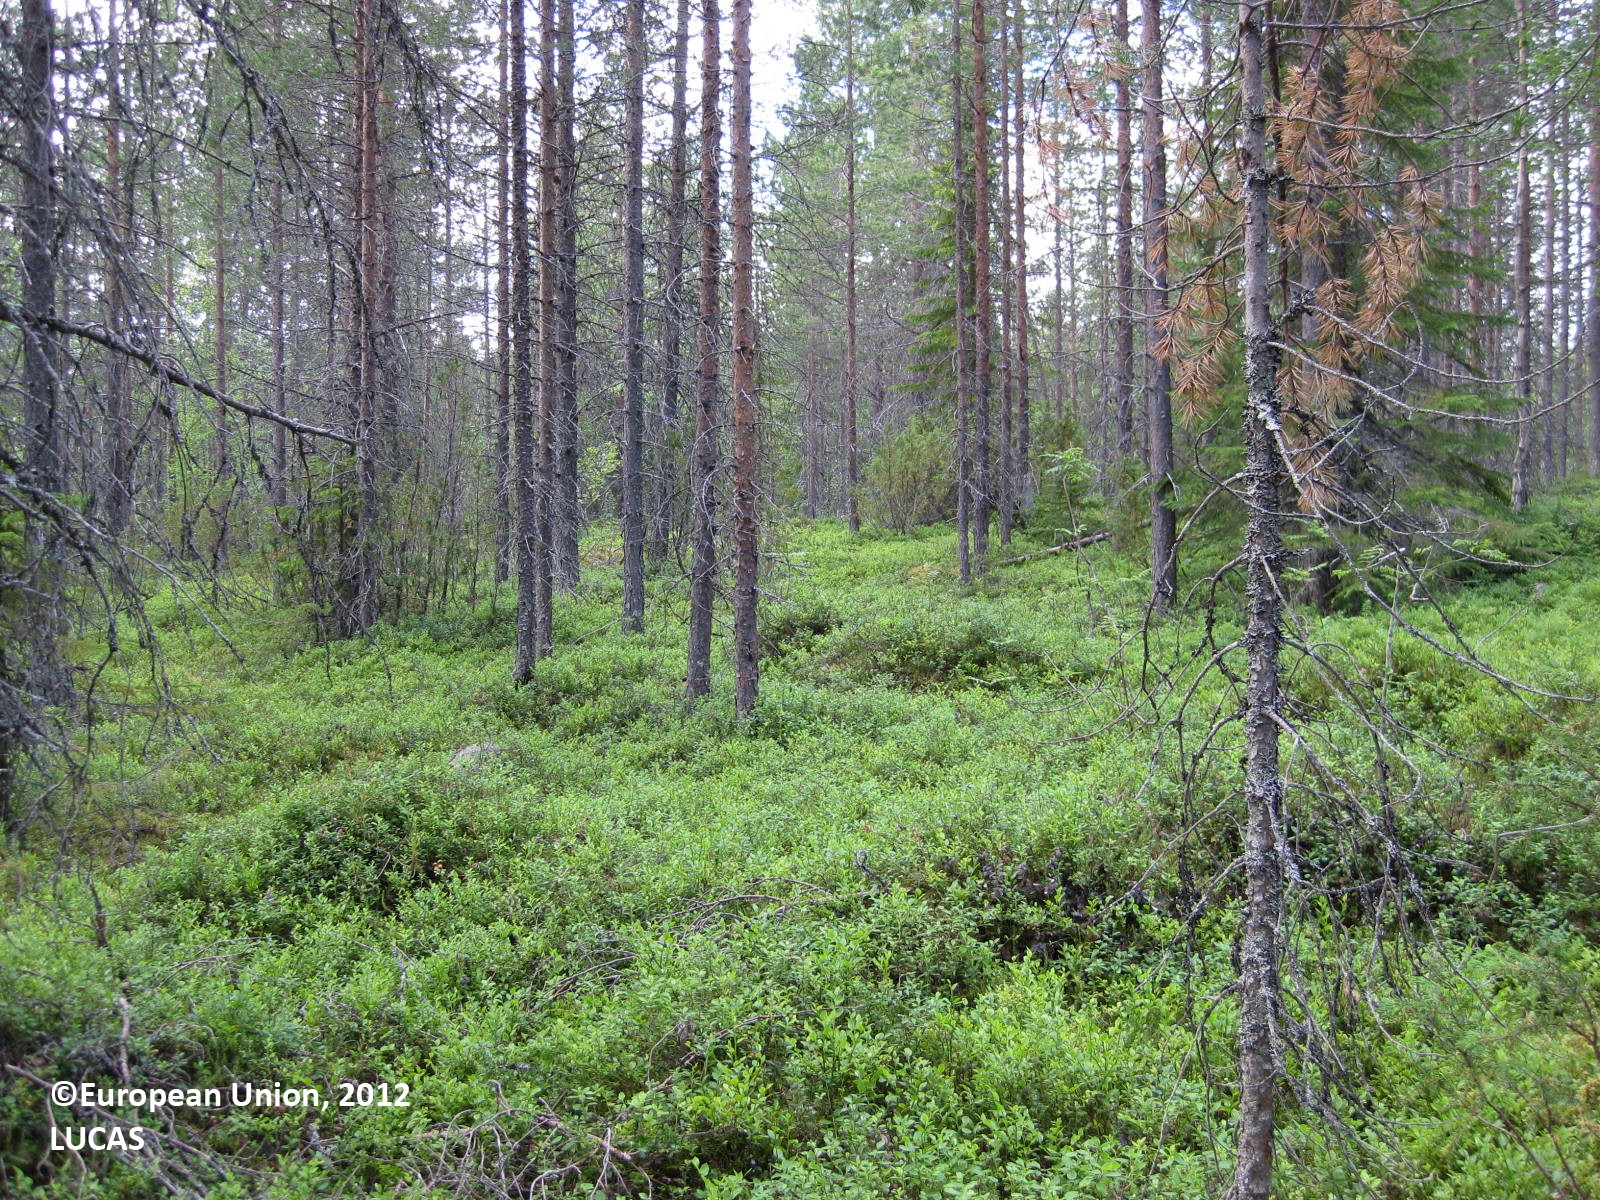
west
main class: Woodland
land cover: Pine dominated coniferous woodland
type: boreal forest
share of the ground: 50 - 75 %
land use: Forestry
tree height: > 5 m
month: July
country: FI
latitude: 65.7428
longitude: 28.5035
